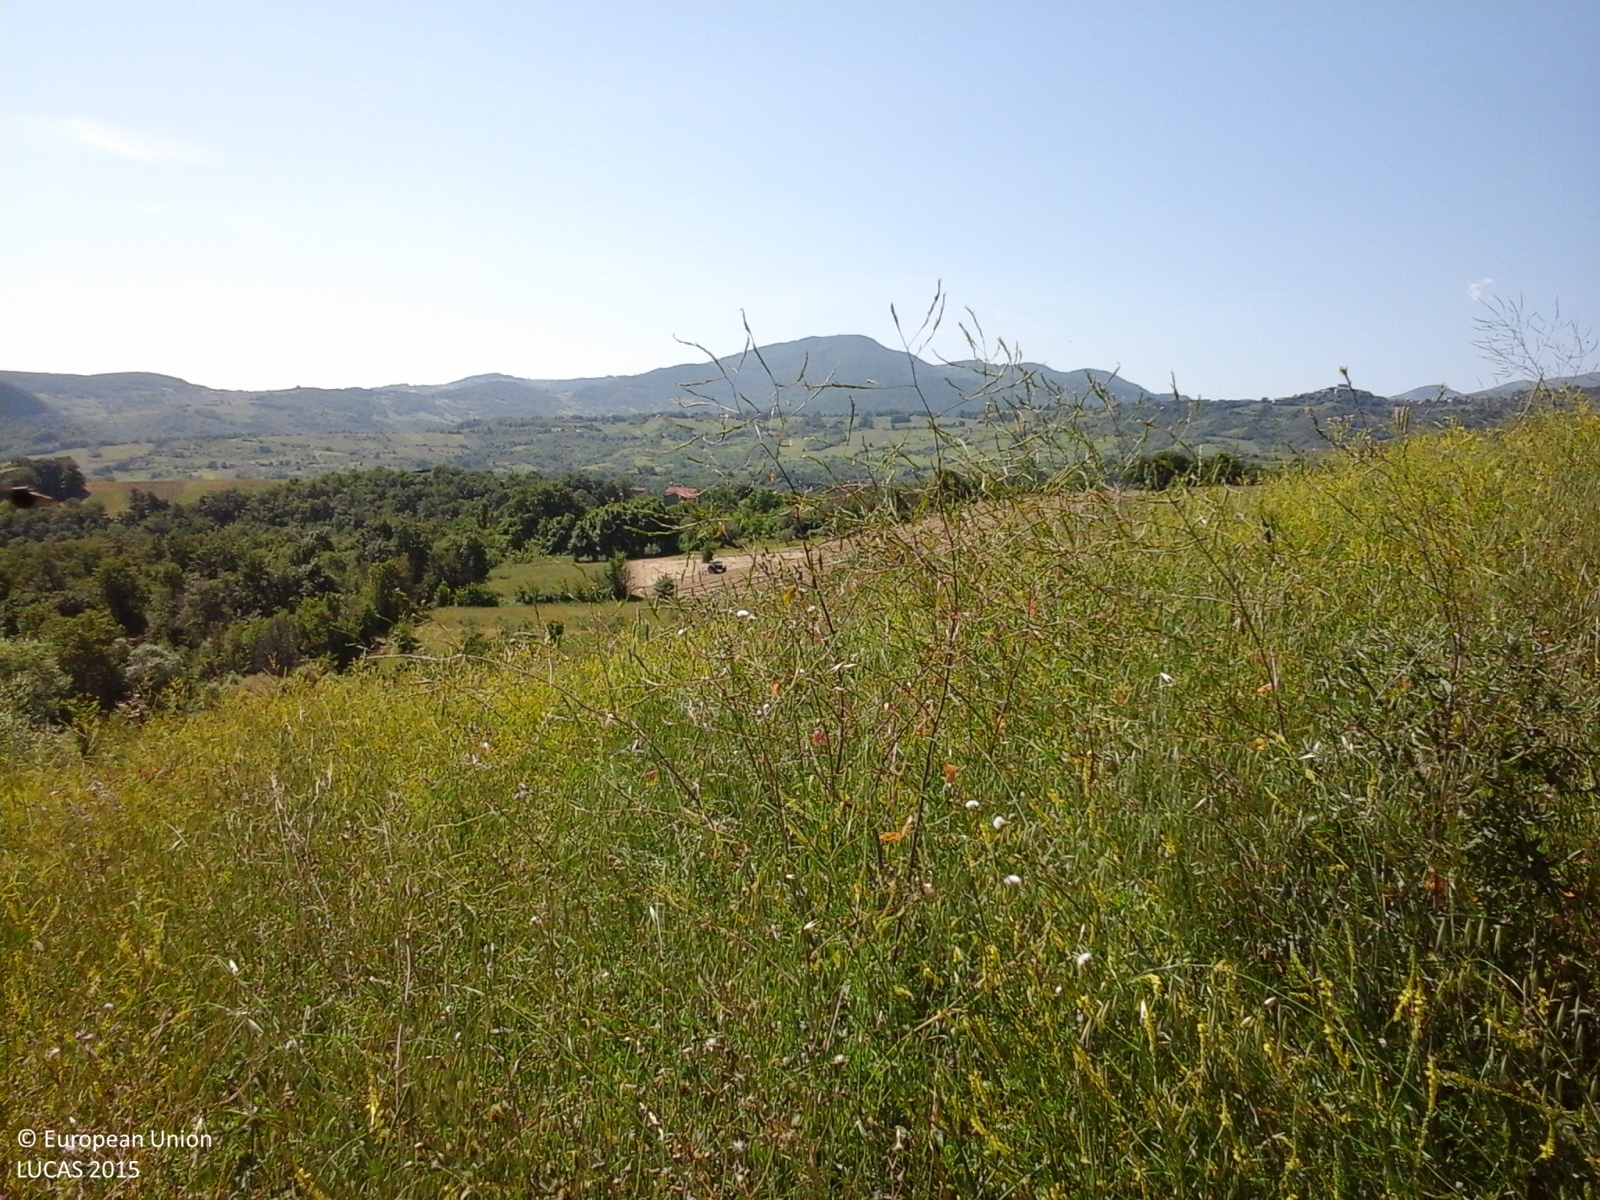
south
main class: Cropland
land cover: Other leguminous and mixtures for fodder
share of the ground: > 75 %
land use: Agriculture (excluding fallow land and kitchen gardens)
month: June
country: IT
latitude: 41.9396
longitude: 14.4843
